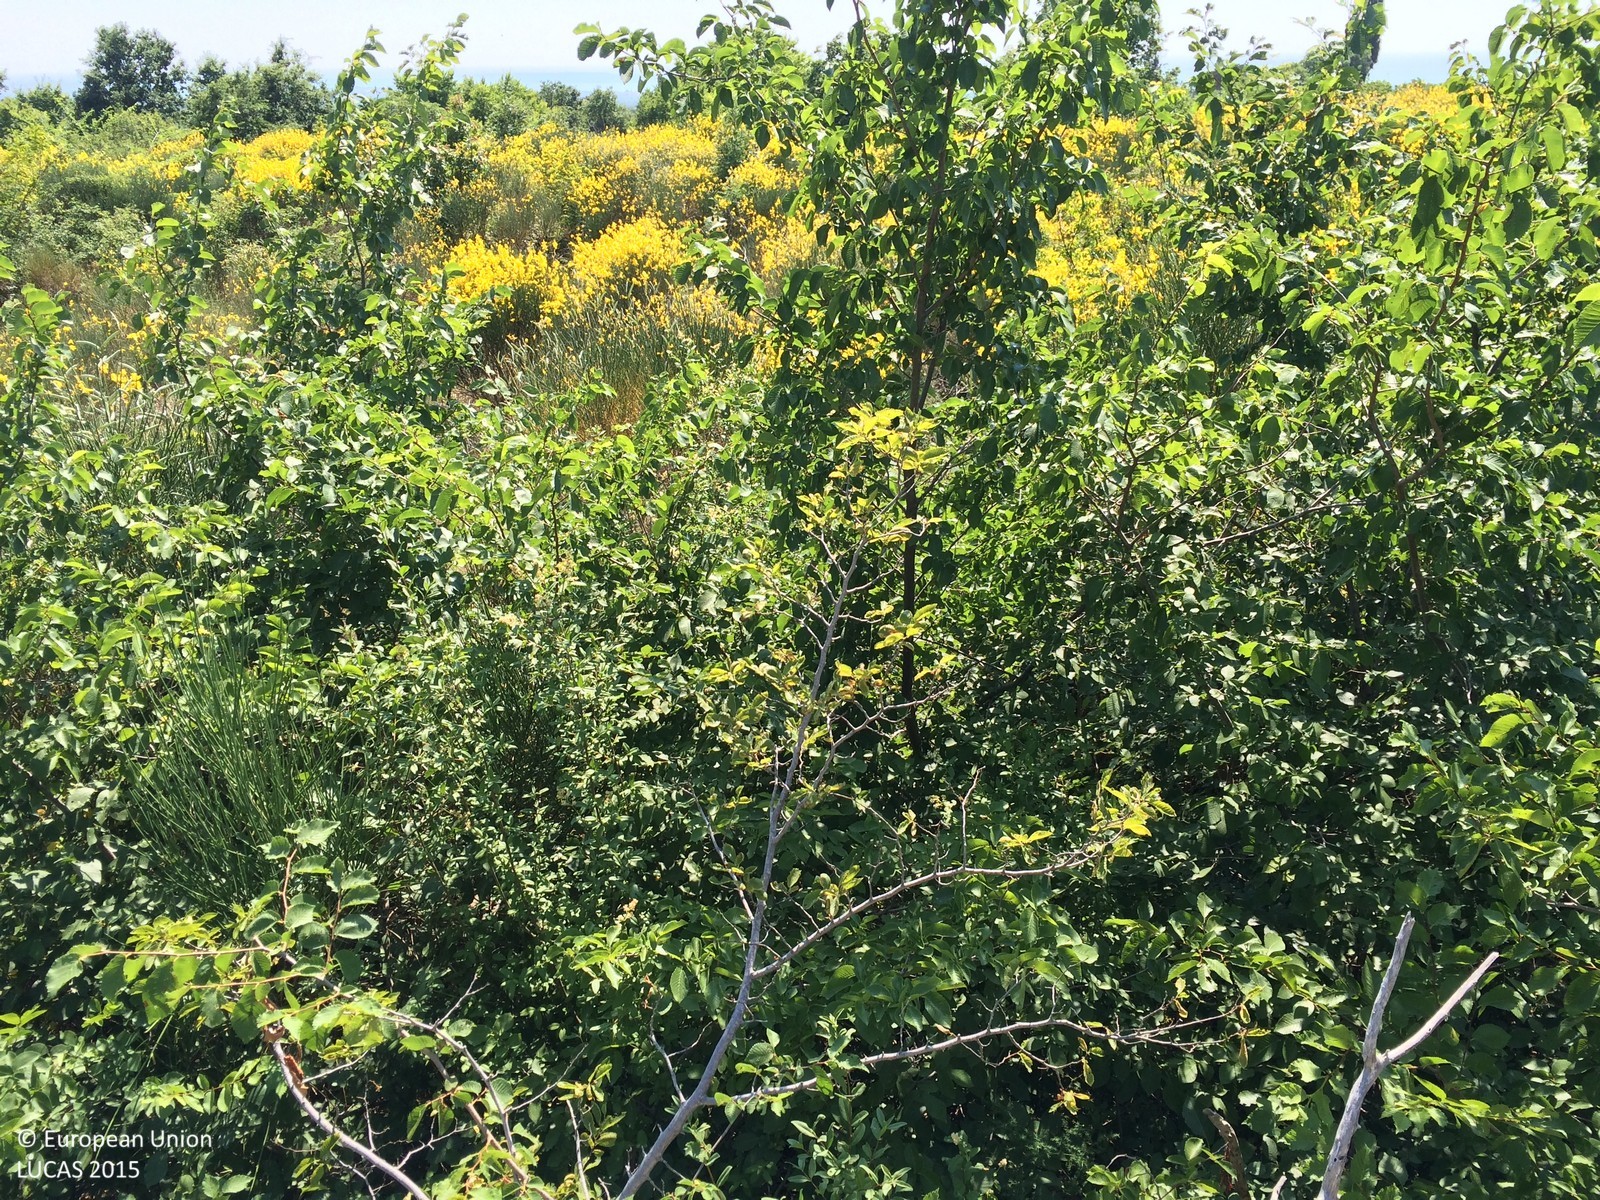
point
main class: Shrubland
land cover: Shrubland with sparse tree cover
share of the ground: > 75 %
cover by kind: shrubs 90 %, broadleaved forest trees 5 %, herbaceous plants 5 %
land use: Semi-natural and natural areas not in use
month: June
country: HR
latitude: 44.9836
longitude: 13.8370
